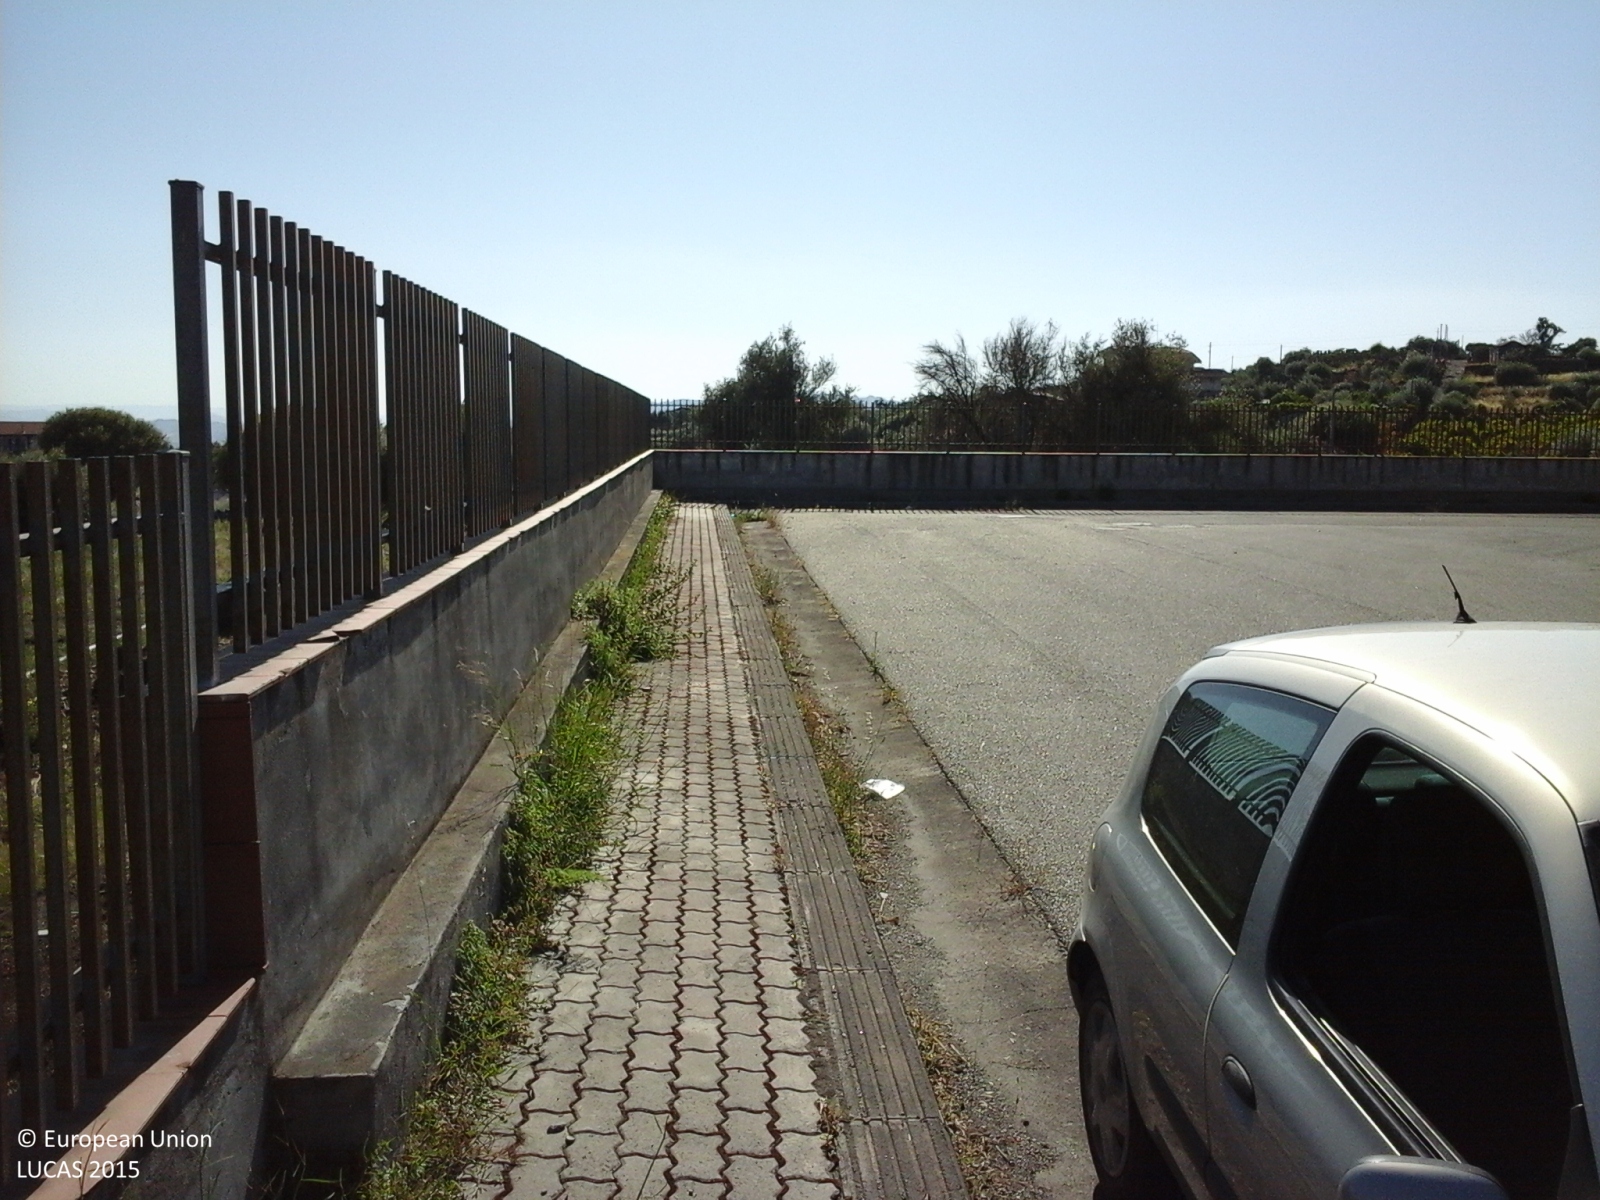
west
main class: Grassland
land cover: Grassland without tree/shrub cover
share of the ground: > 75 %
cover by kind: herbaceous plants 100 %
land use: Abandoned areas
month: May
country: IT
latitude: 37.6215
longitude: 14.8938
